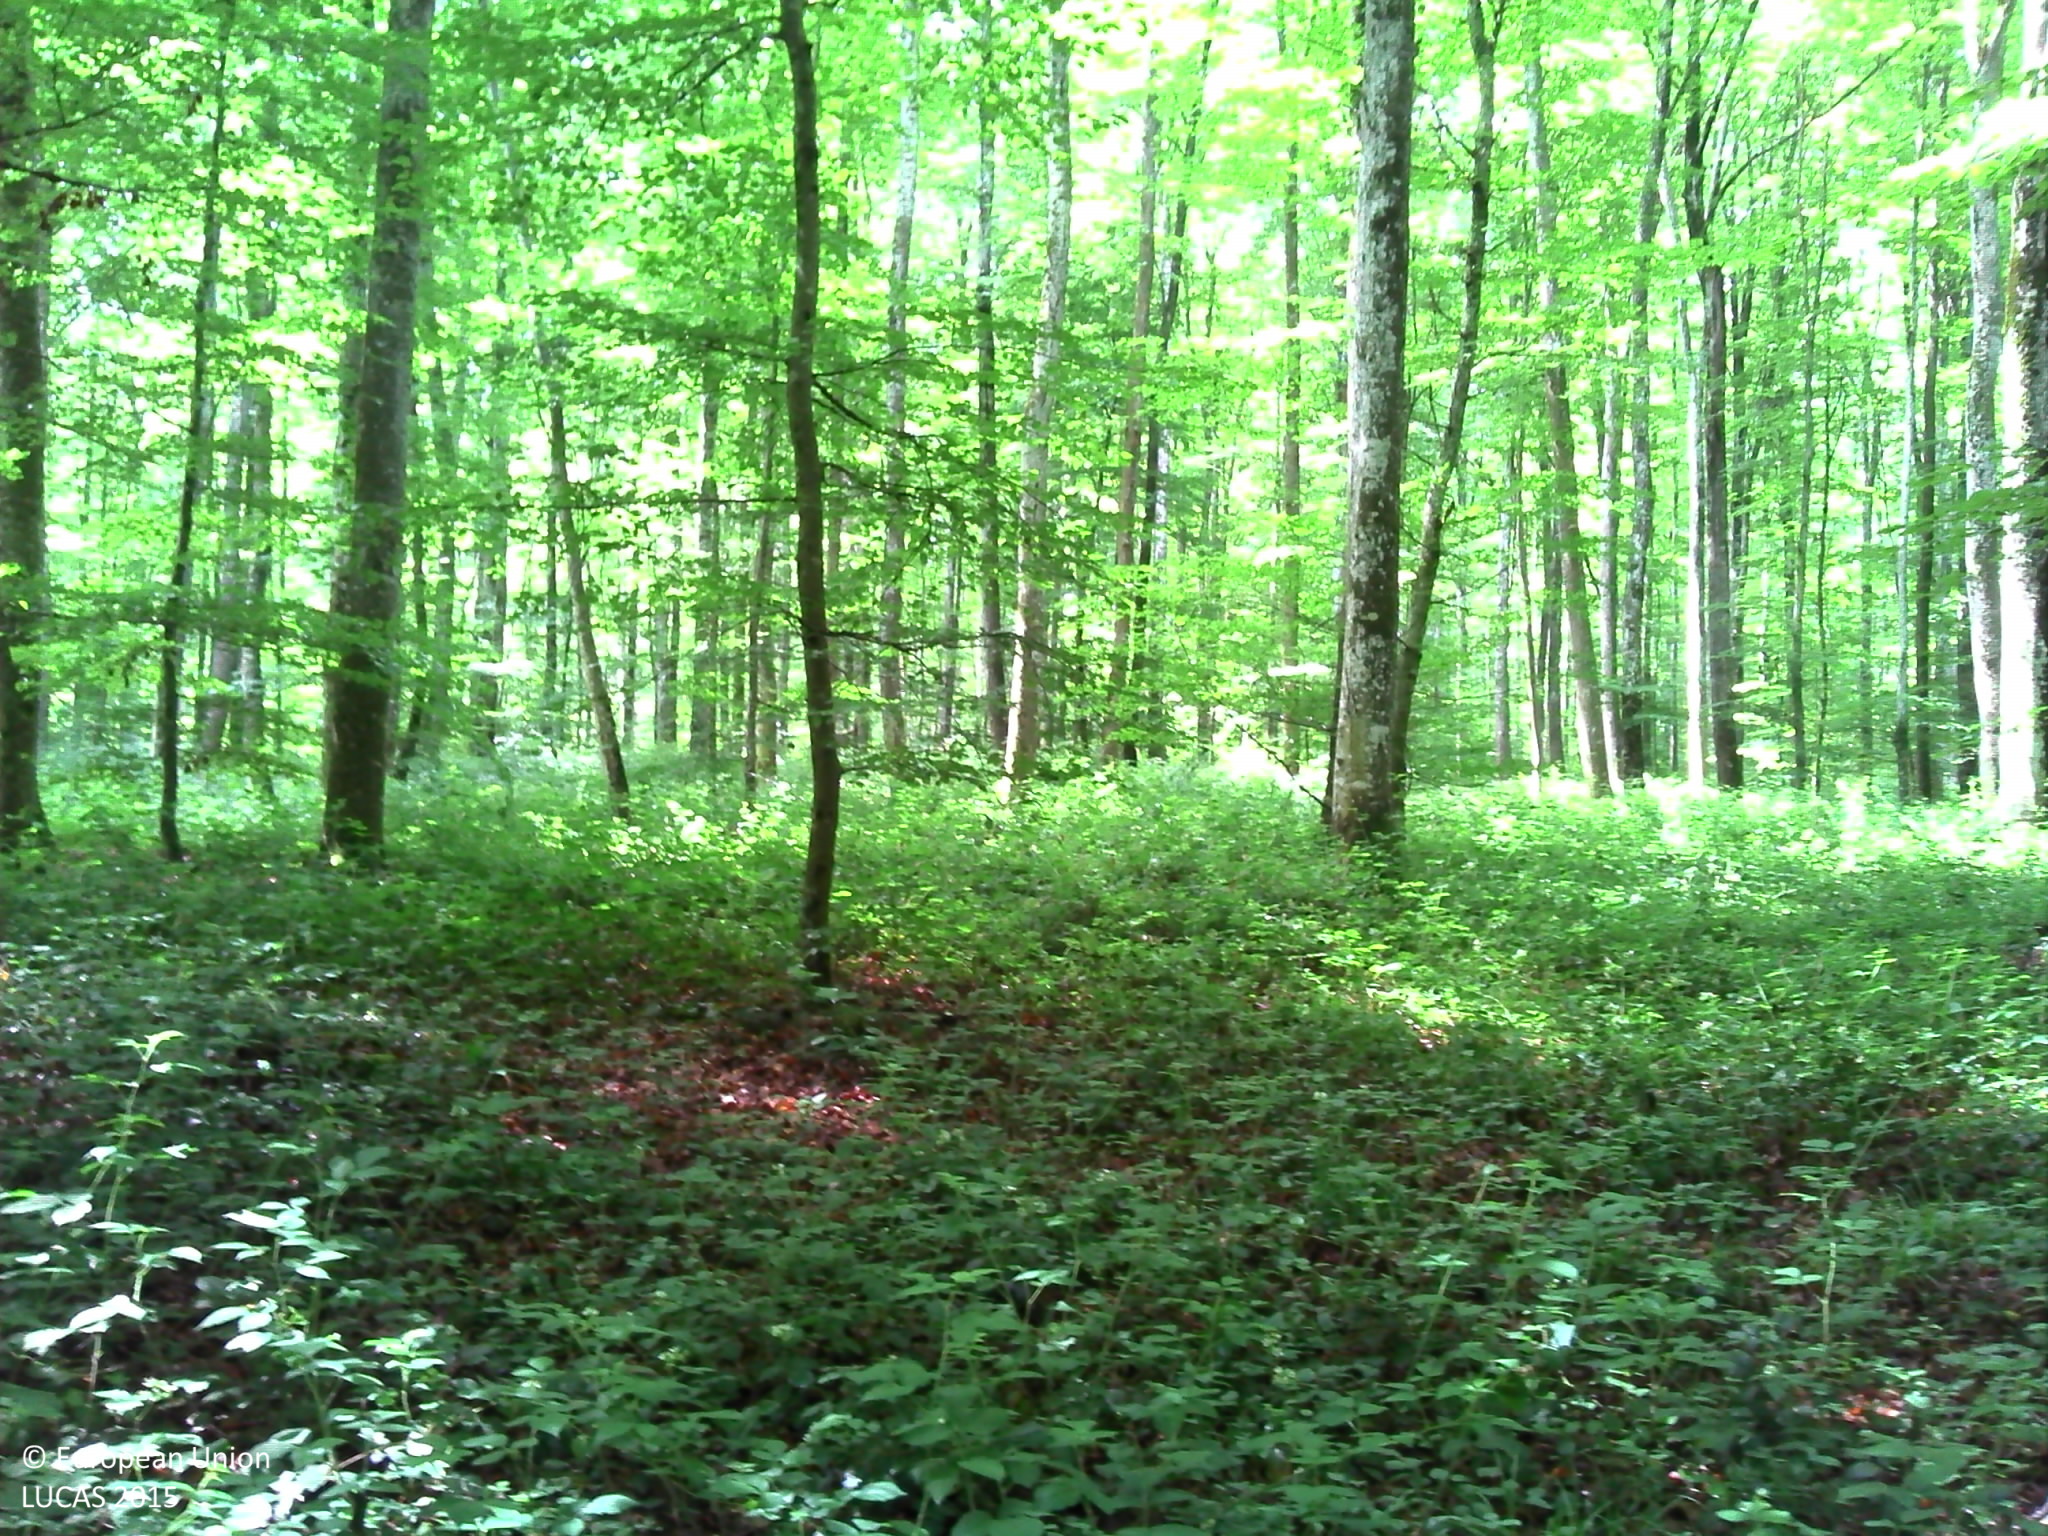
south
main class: Woodland
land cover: Broadleaved woodland
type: beech forest
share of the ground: > 75 %
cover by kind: broadleaved forest trees 90 %, shrubs 5 %, herbaceous plants 5 %
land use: Forestry
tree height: > 5 m
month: June
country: FR
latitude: 46.2129
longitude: 3.0114
